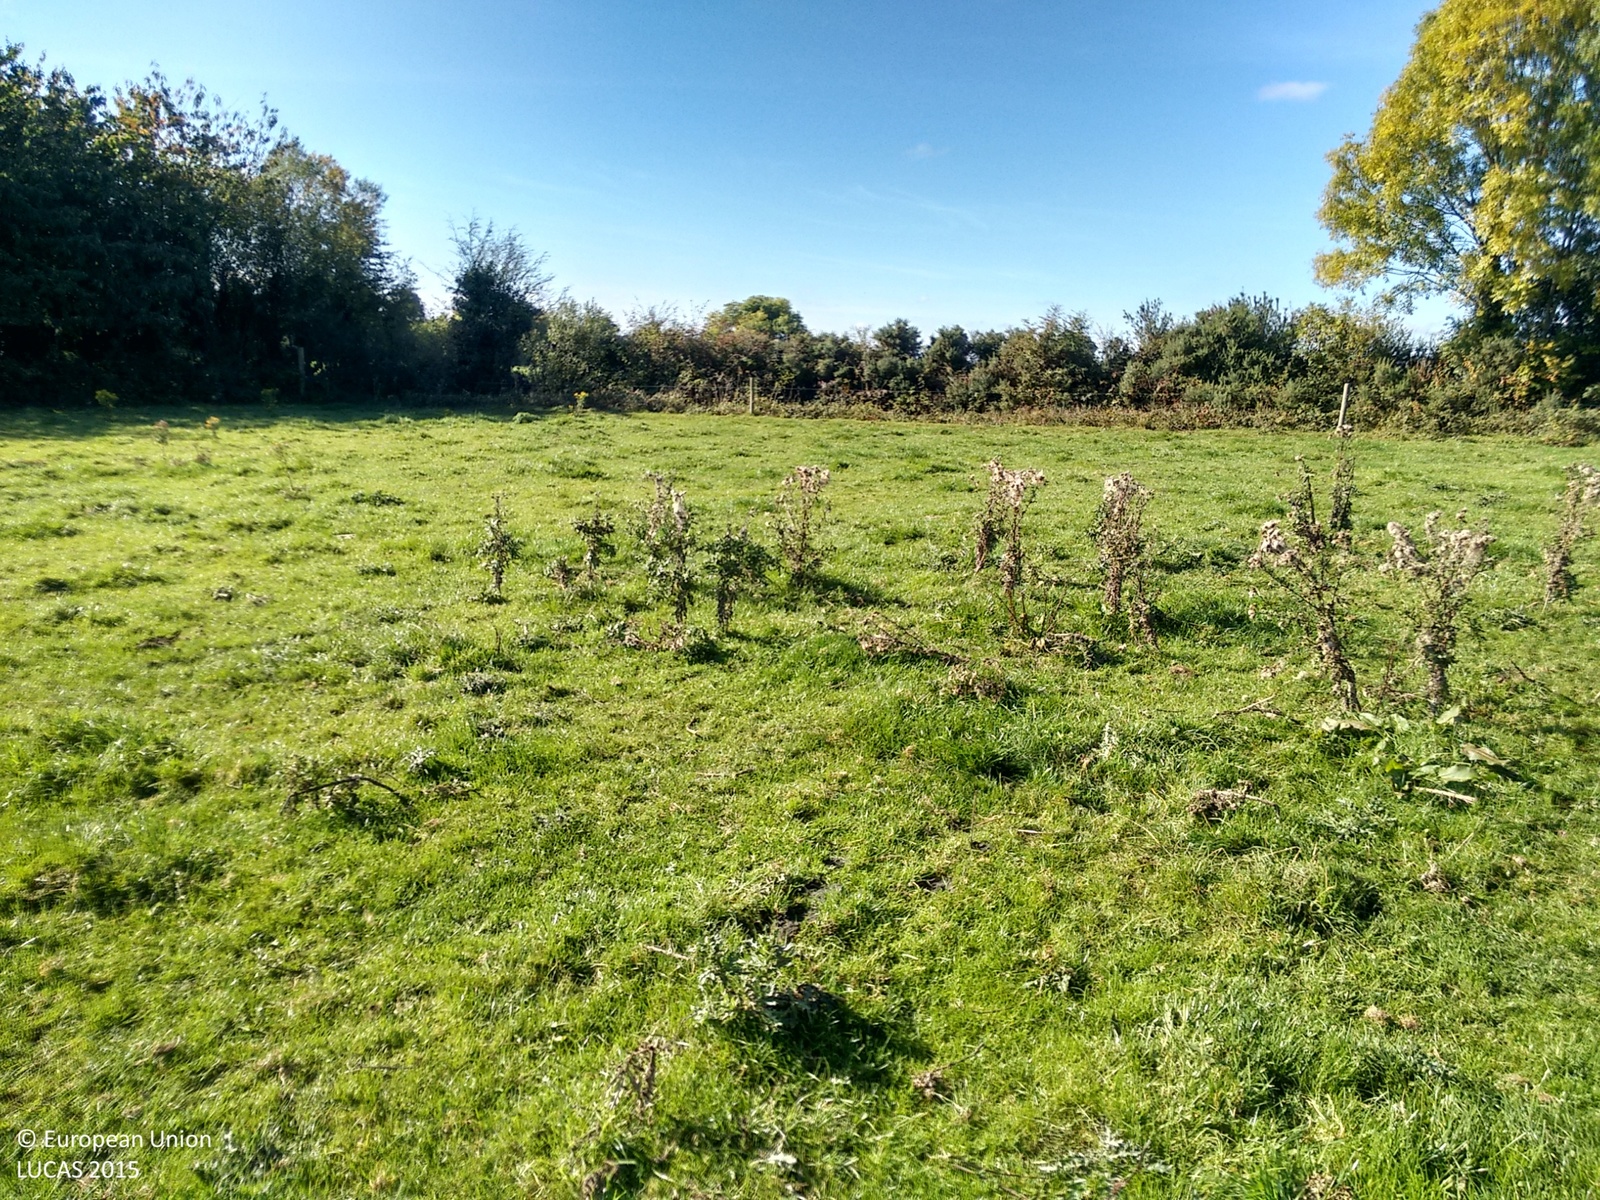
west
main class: Grassland
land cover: Grassland without tree/shrub cover
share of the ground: > 75 %
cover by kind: herbaceous plants 100 %
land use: Agriculture (excluding fallow land and kitchen gardens)
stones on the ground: < 10 %
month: October
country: IE
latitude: 52.9729
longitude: -7.4148
